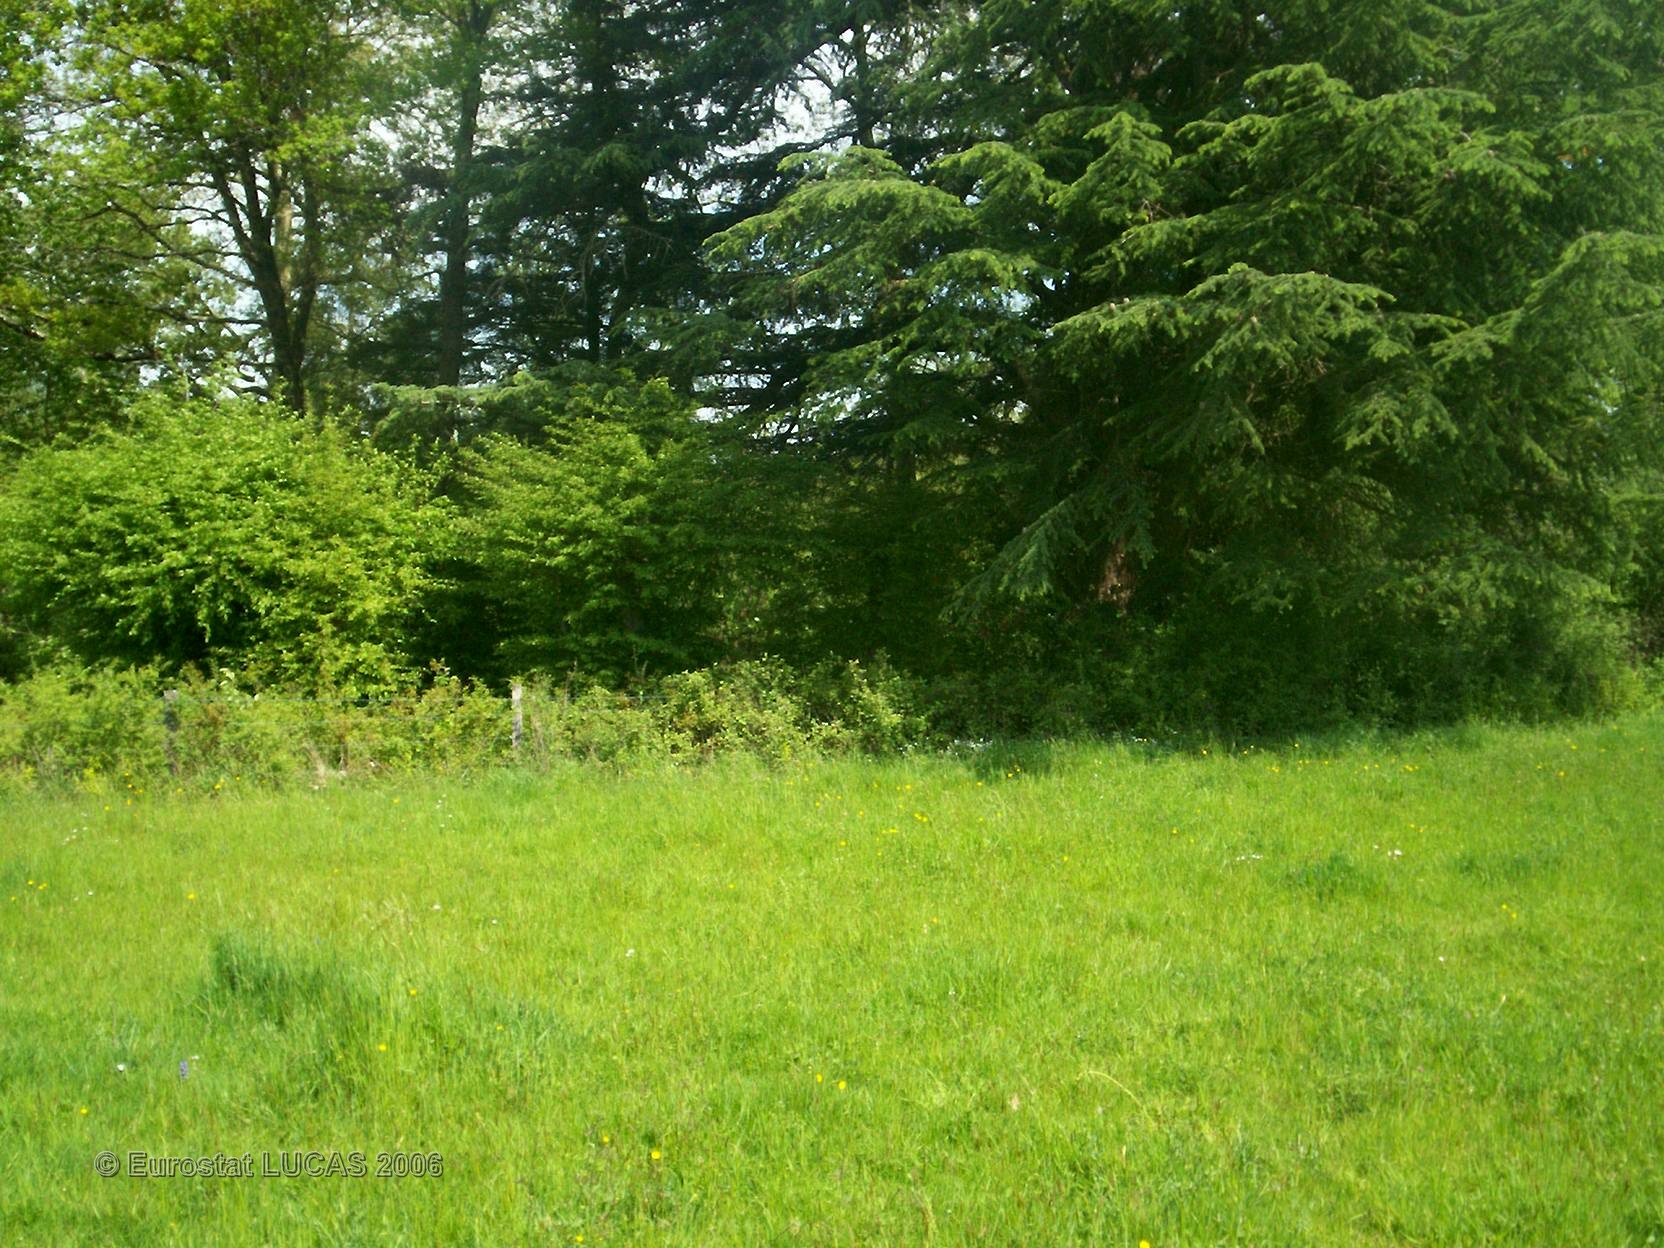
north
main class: Grassland
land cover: Grassland without tree/shrub cover
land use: Agriculture (excluding fallow land and kitchen gardens)
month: May
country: FR
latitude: 45.9619
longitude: 0.6828
